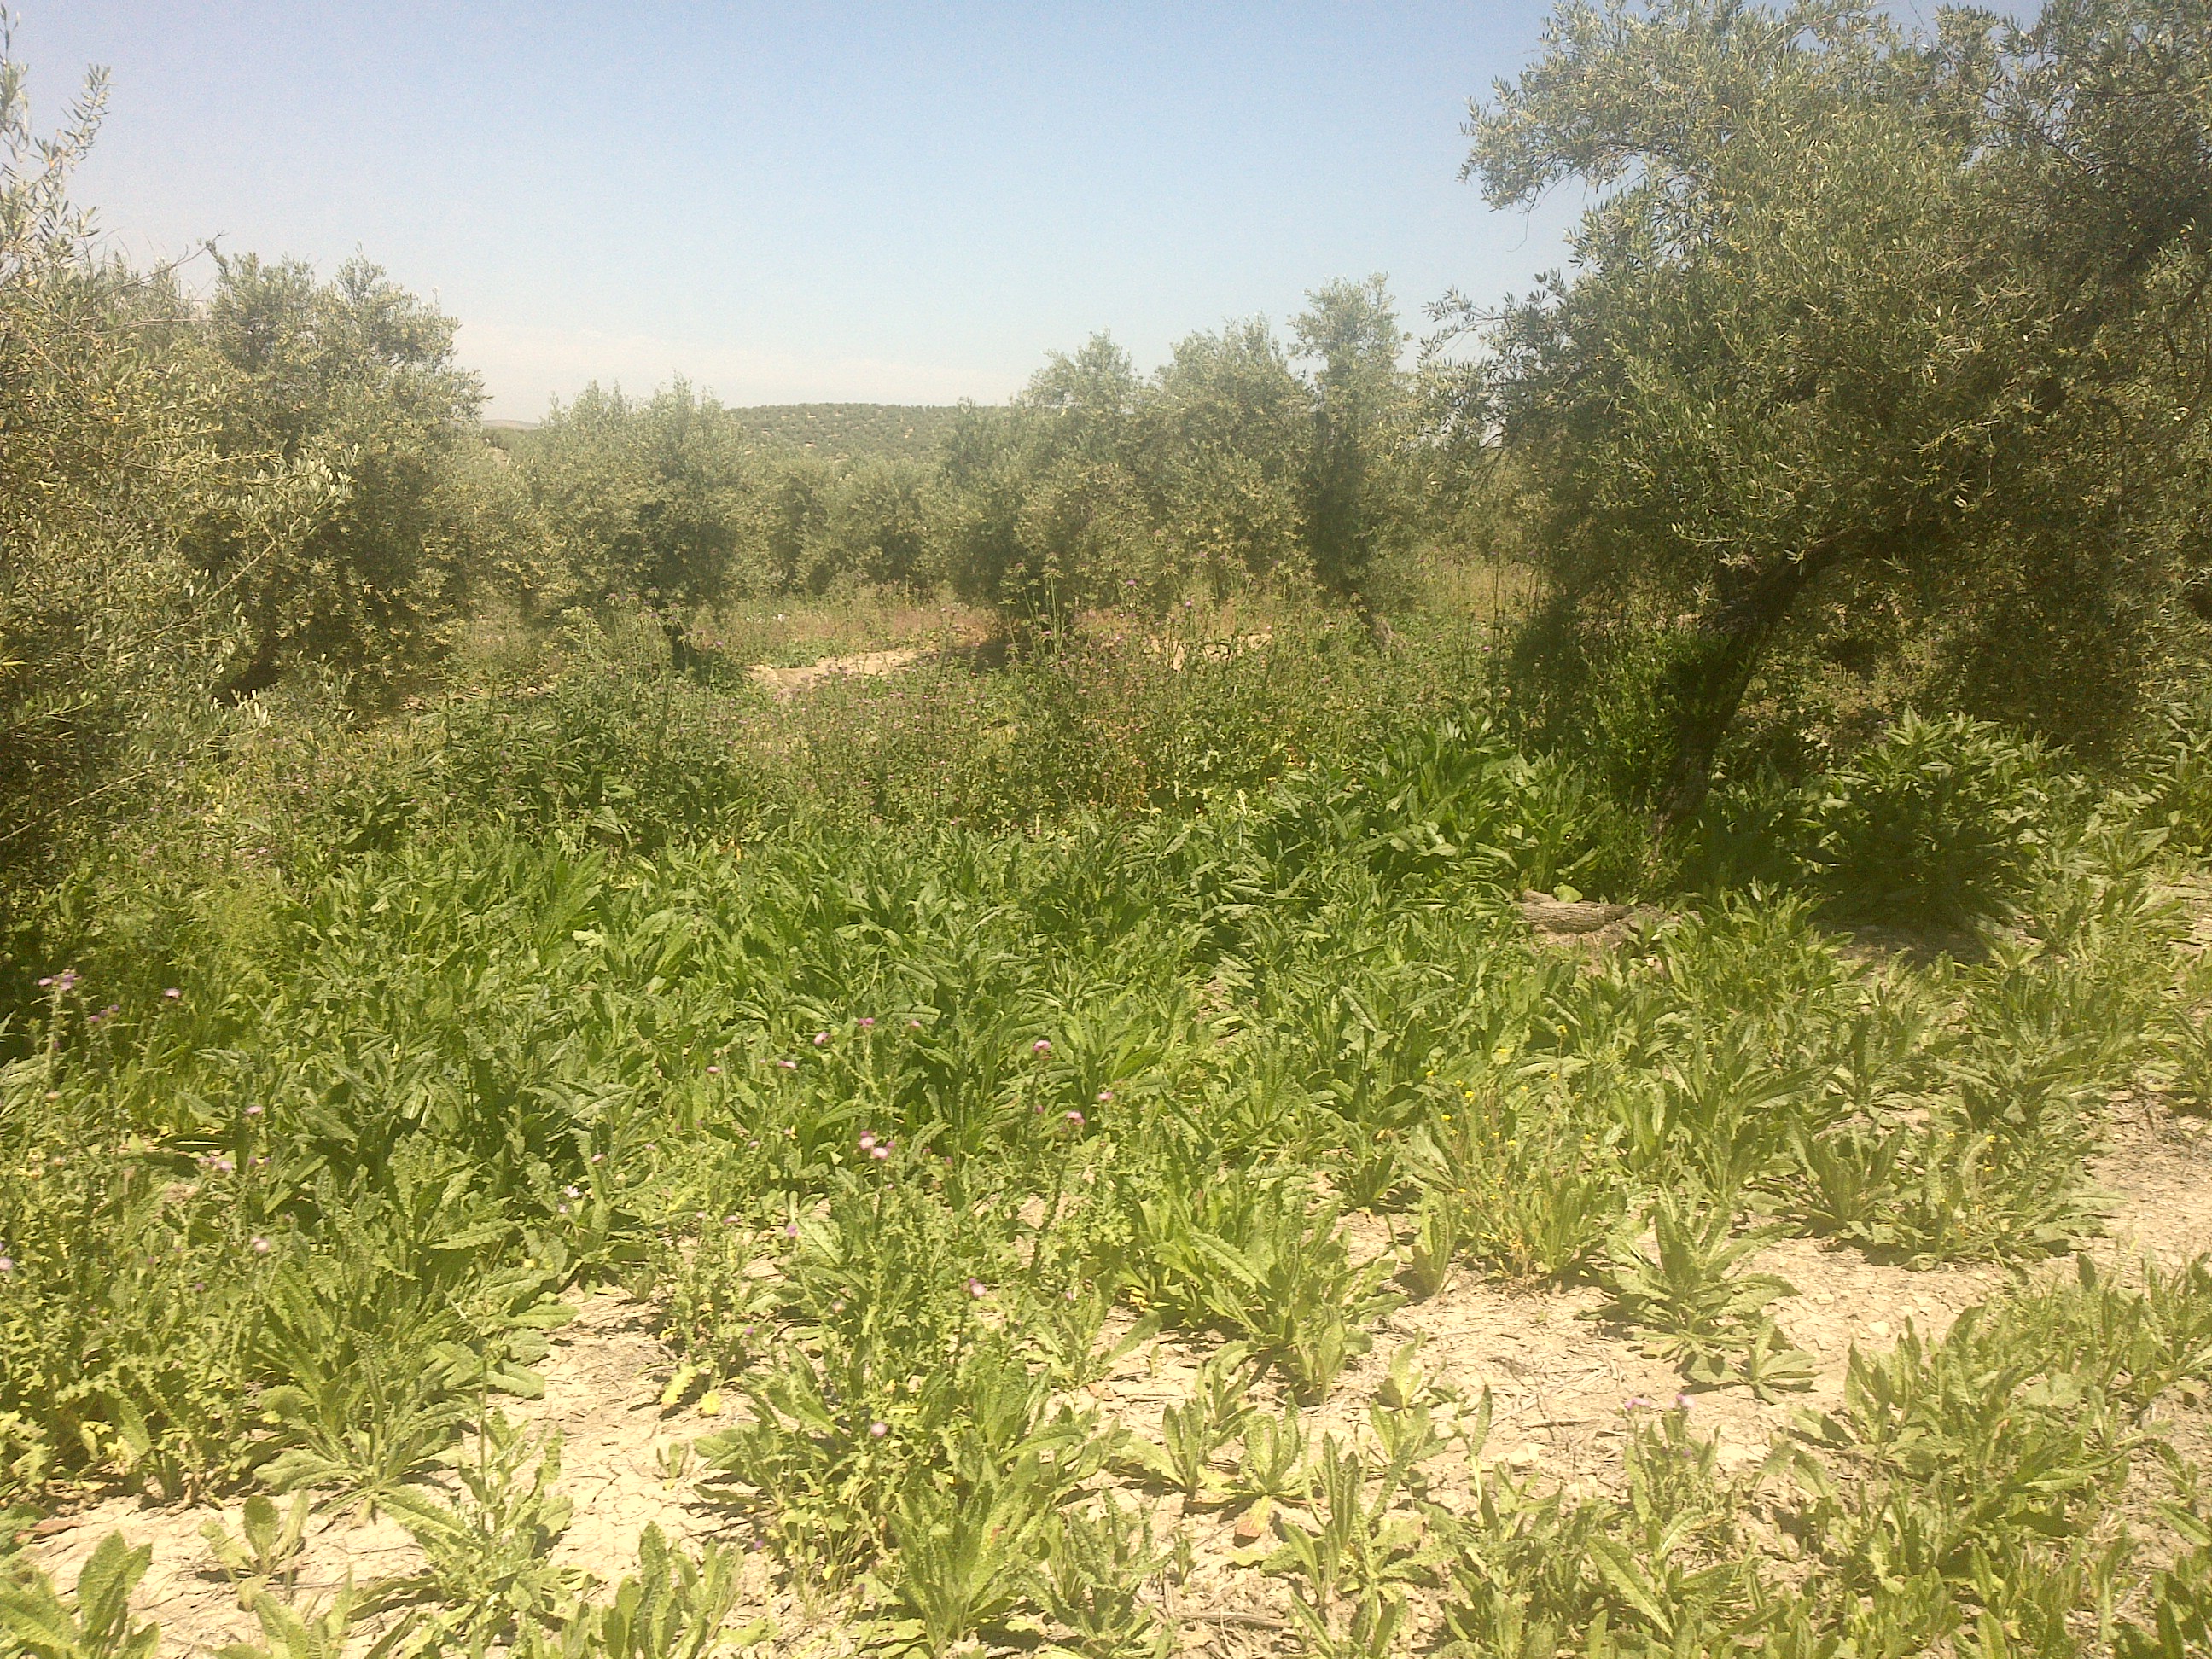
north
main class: Cropland
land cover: Olive groves
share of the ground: 50 - 75 %
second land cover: Spontaneously vegetated surfaces
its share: 50 - 75 %
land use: Agriculture (excluding fallow land and kitchen gardens)
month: May
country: ES
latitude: 37.6805
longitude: -4.6018
